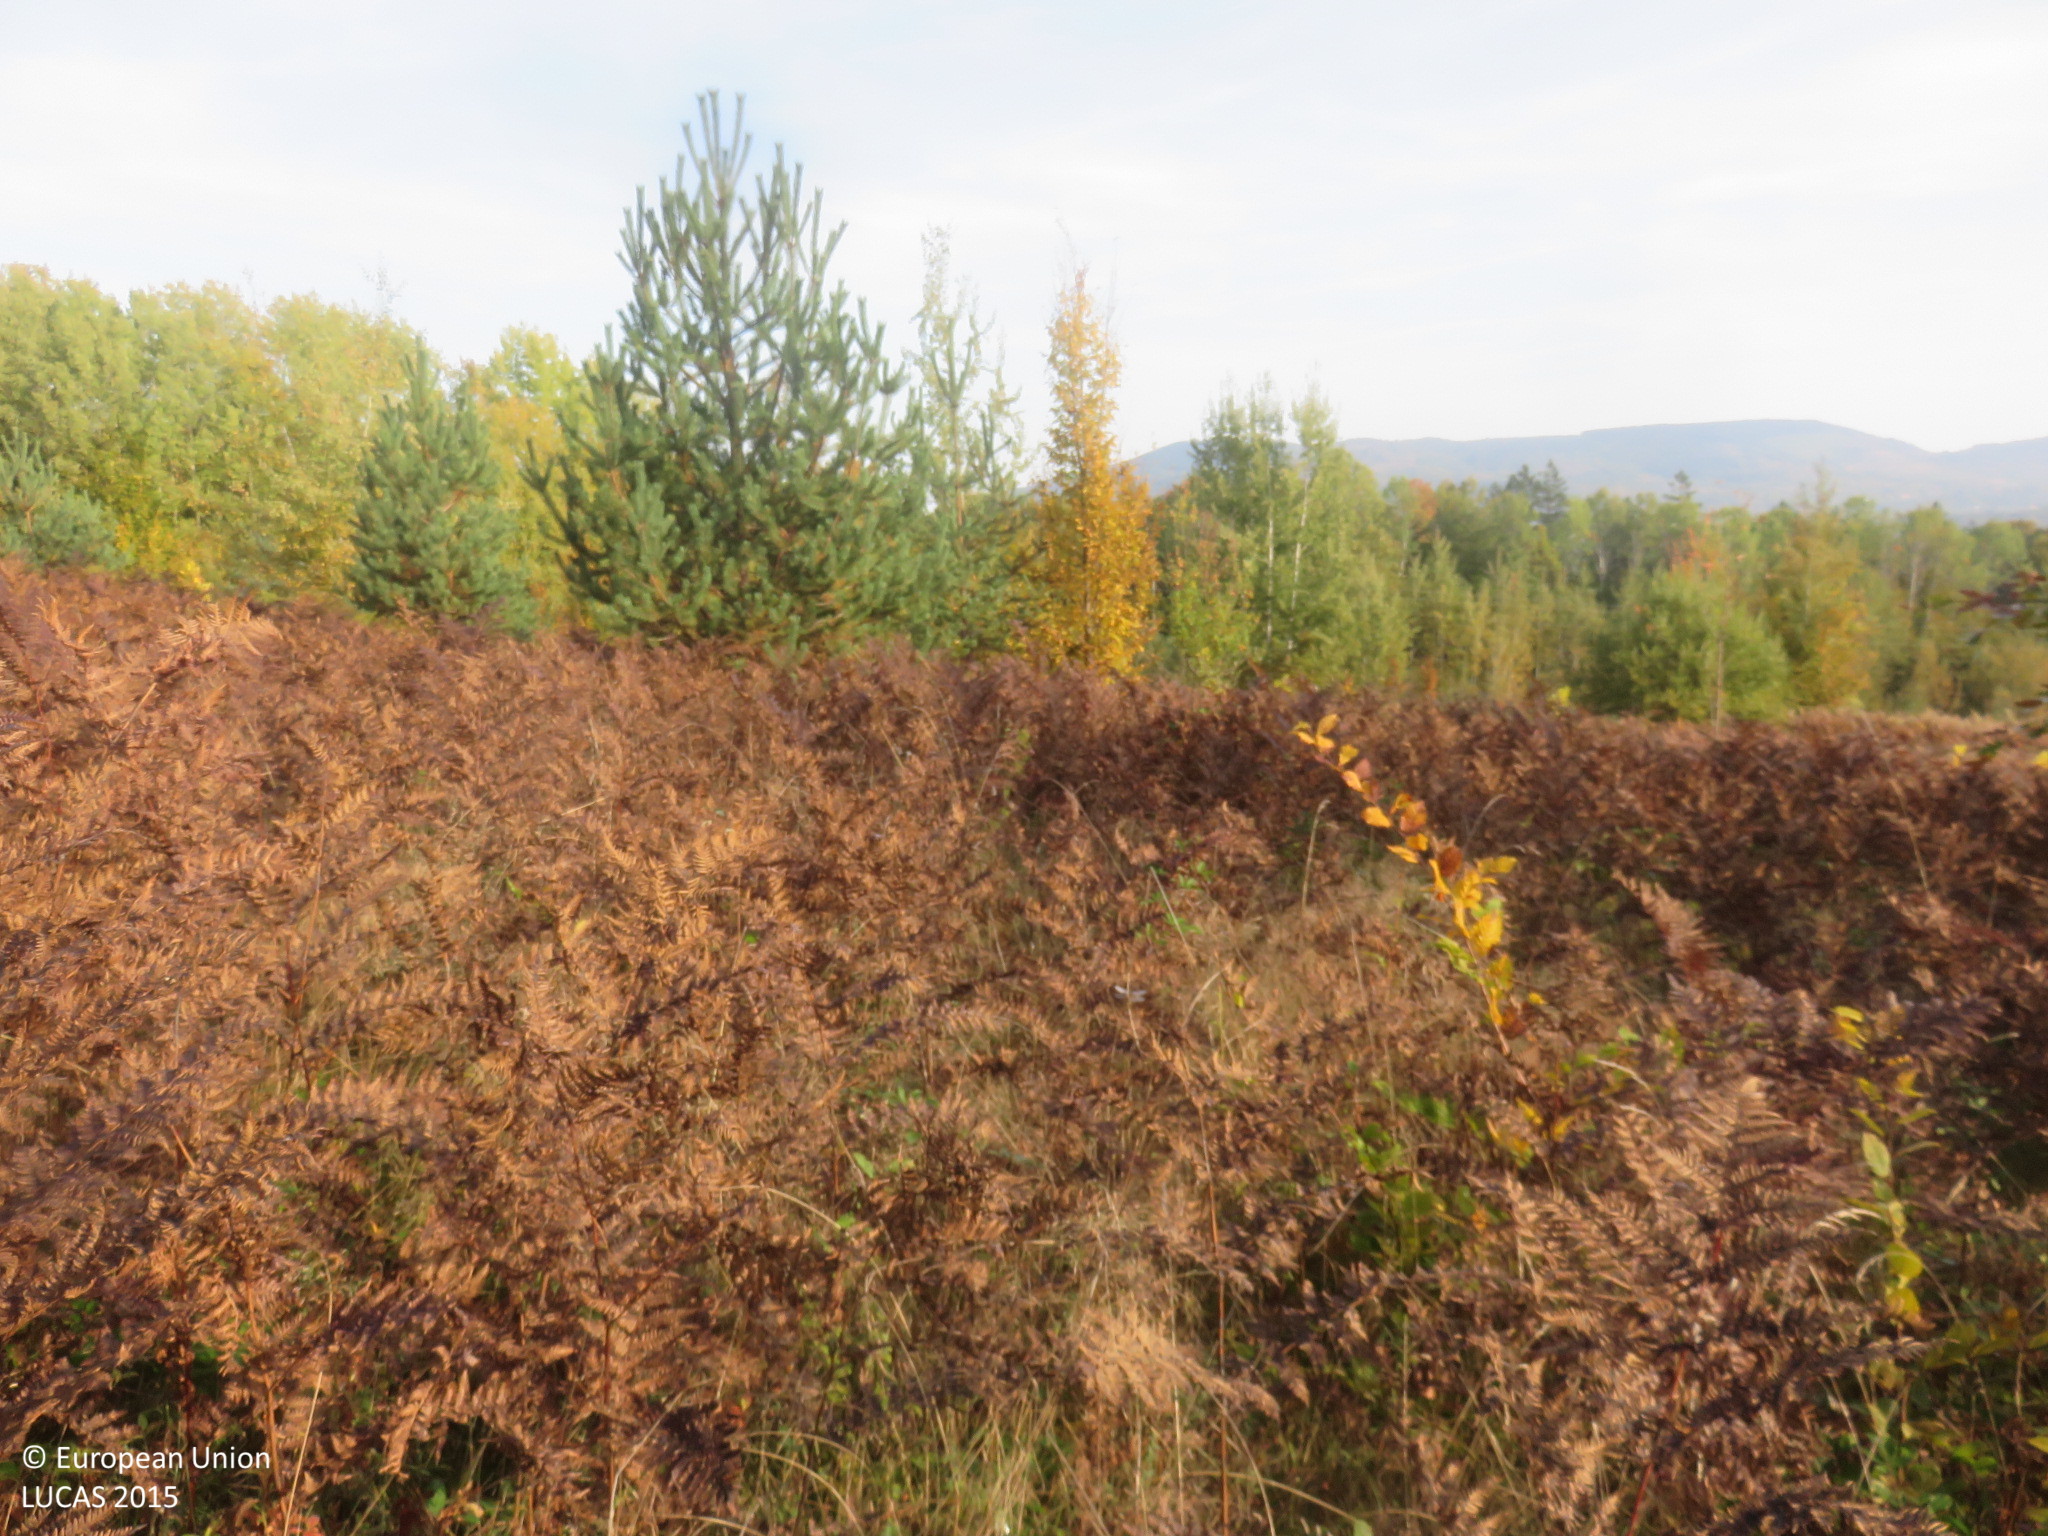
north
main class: Grassland
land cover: Grassland with sparse tree/shrub cover
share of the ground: > 75 %
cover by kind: herbaceous plants 90 %, broadleaved forest trees 5 %, shrubs 5 %
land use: Abandoned areas
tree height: < 5 m
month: October
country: BG
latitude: 42.8951
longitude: 24.8175
